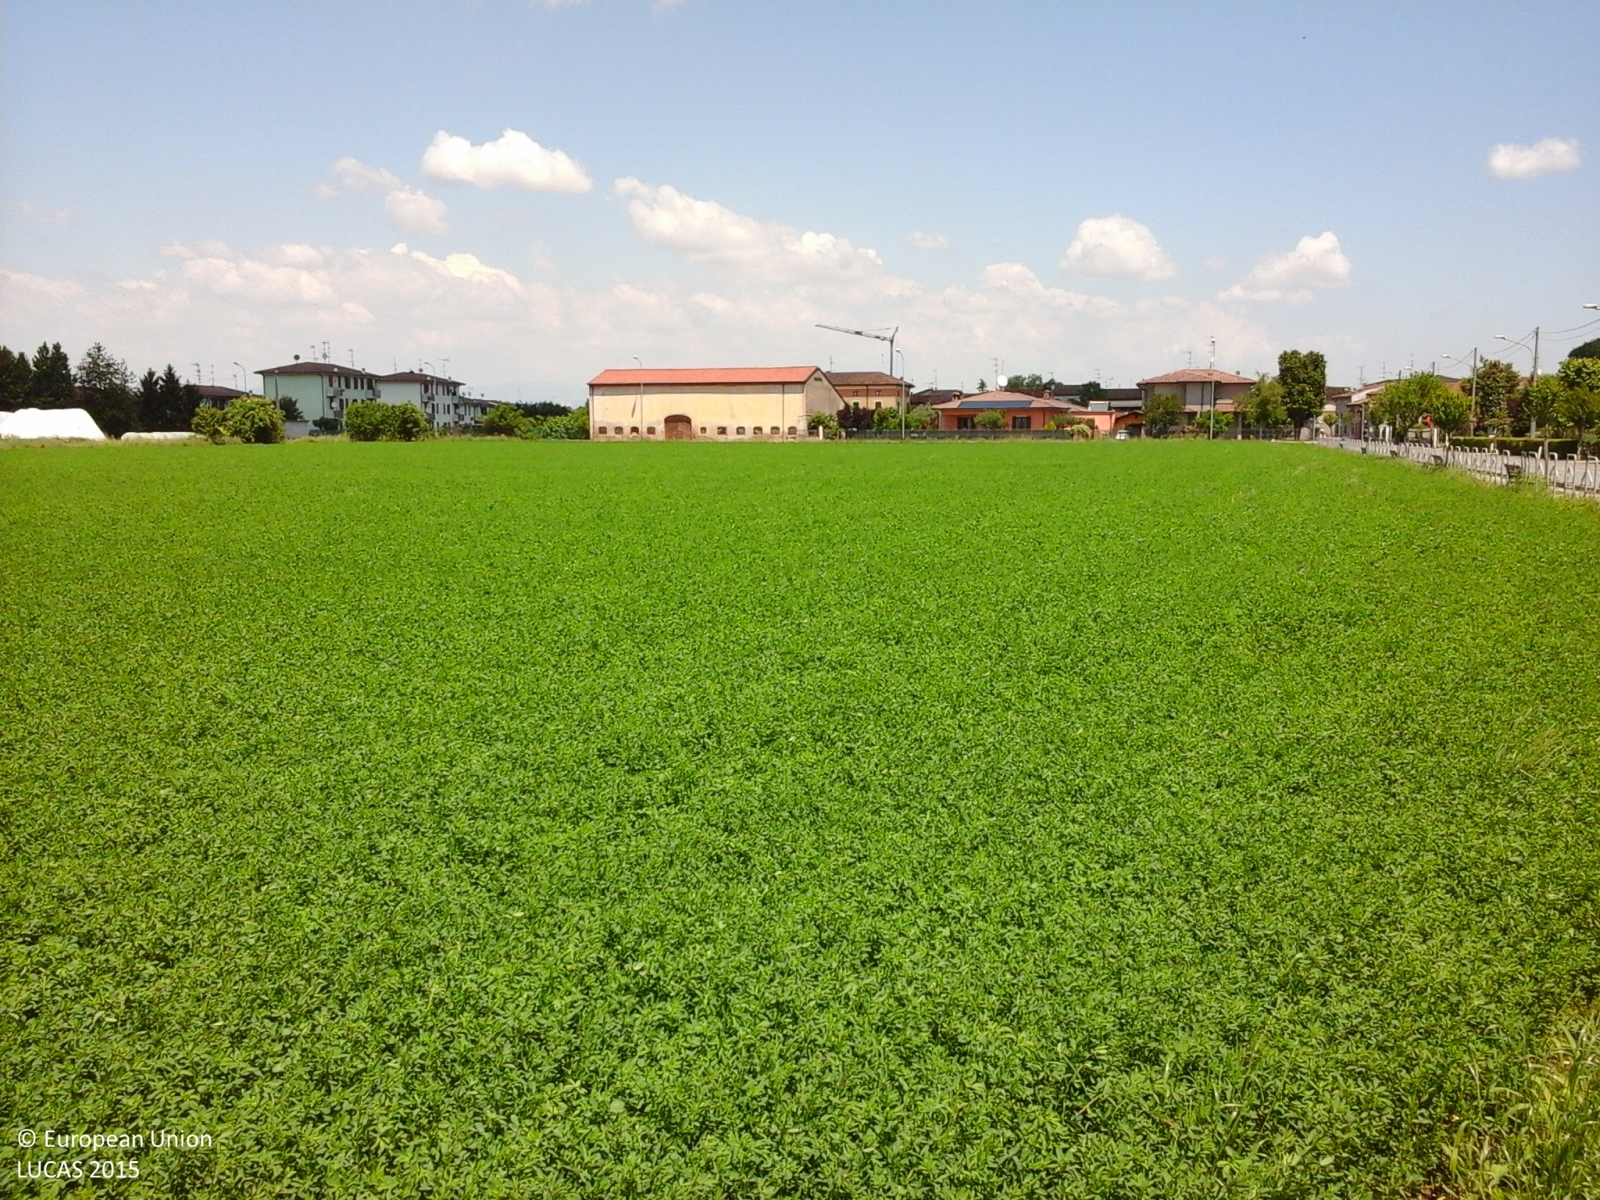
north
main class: Cropland
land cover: Lucerne
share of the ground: > 75 %
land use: Agriculture (excluding fallow land and kitchen gardens)
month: May
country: IT
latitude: 45.3057
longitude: 10.3183
